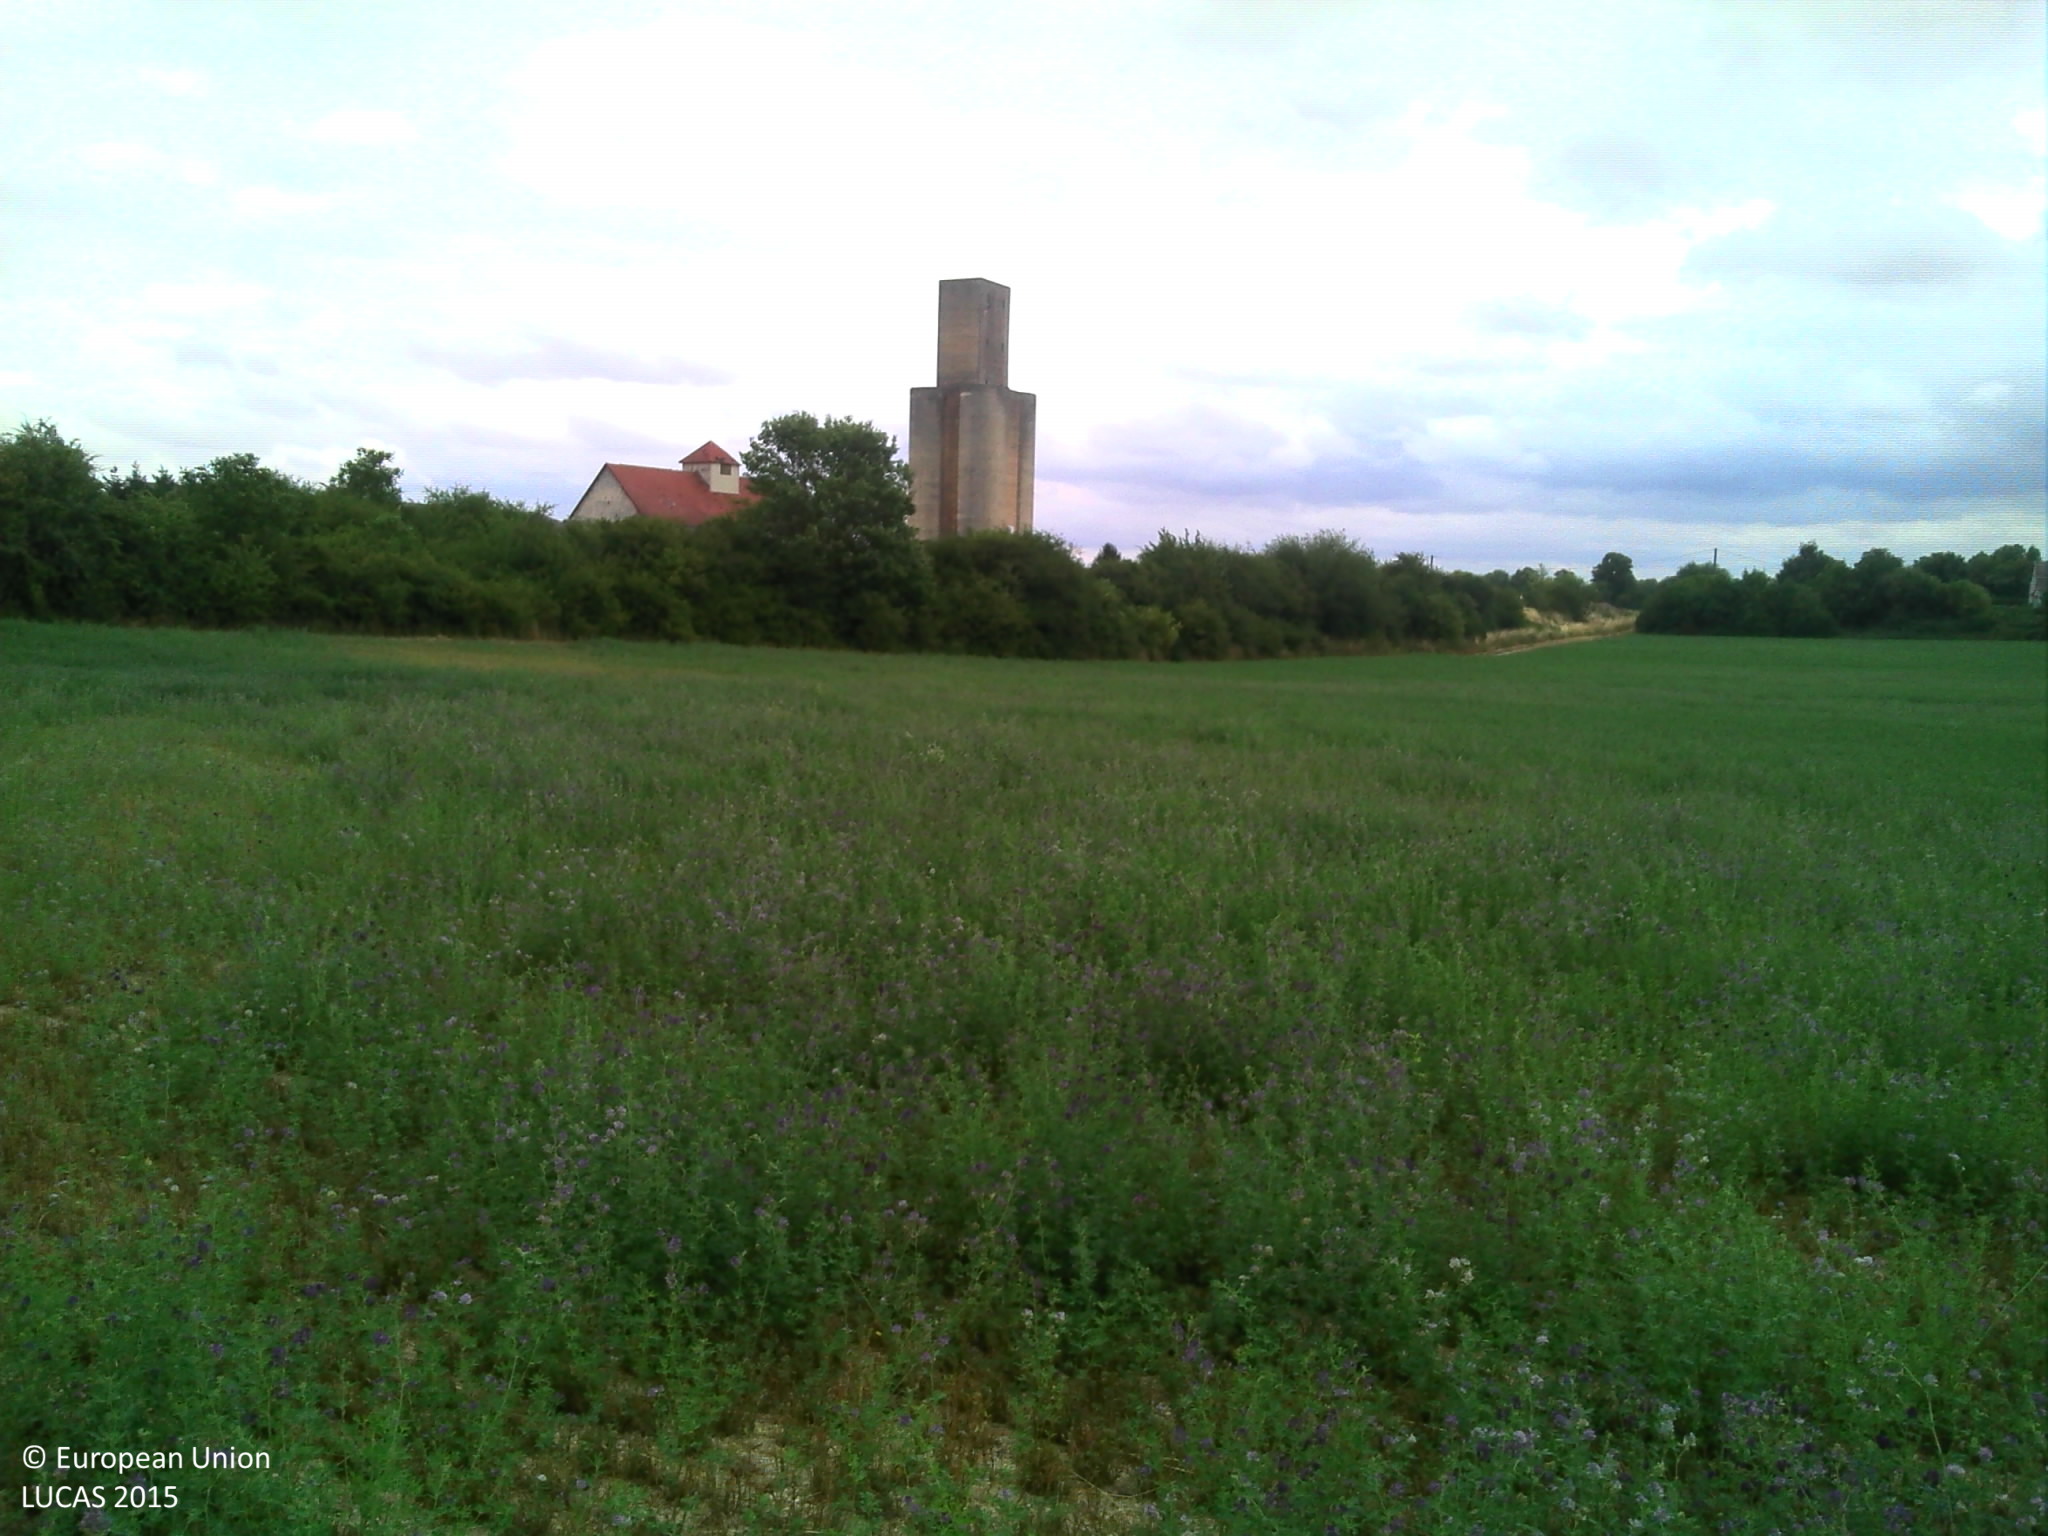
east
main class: Cropland
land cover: Lucerne
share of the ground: > 75 %
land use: Agriculture (excluding fallow land and kitchen gardens)
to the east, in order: Lucerne; Grass margins; Tracks; Grass margins; Broadleaved woodland; Railways; Shrubland without tree cover; Tracks; Grassland without tree/shrub cover; Ditches and canals; Artificial constructions in urban areas
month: July
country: FR
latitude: 48.7378
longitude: 4.1899
